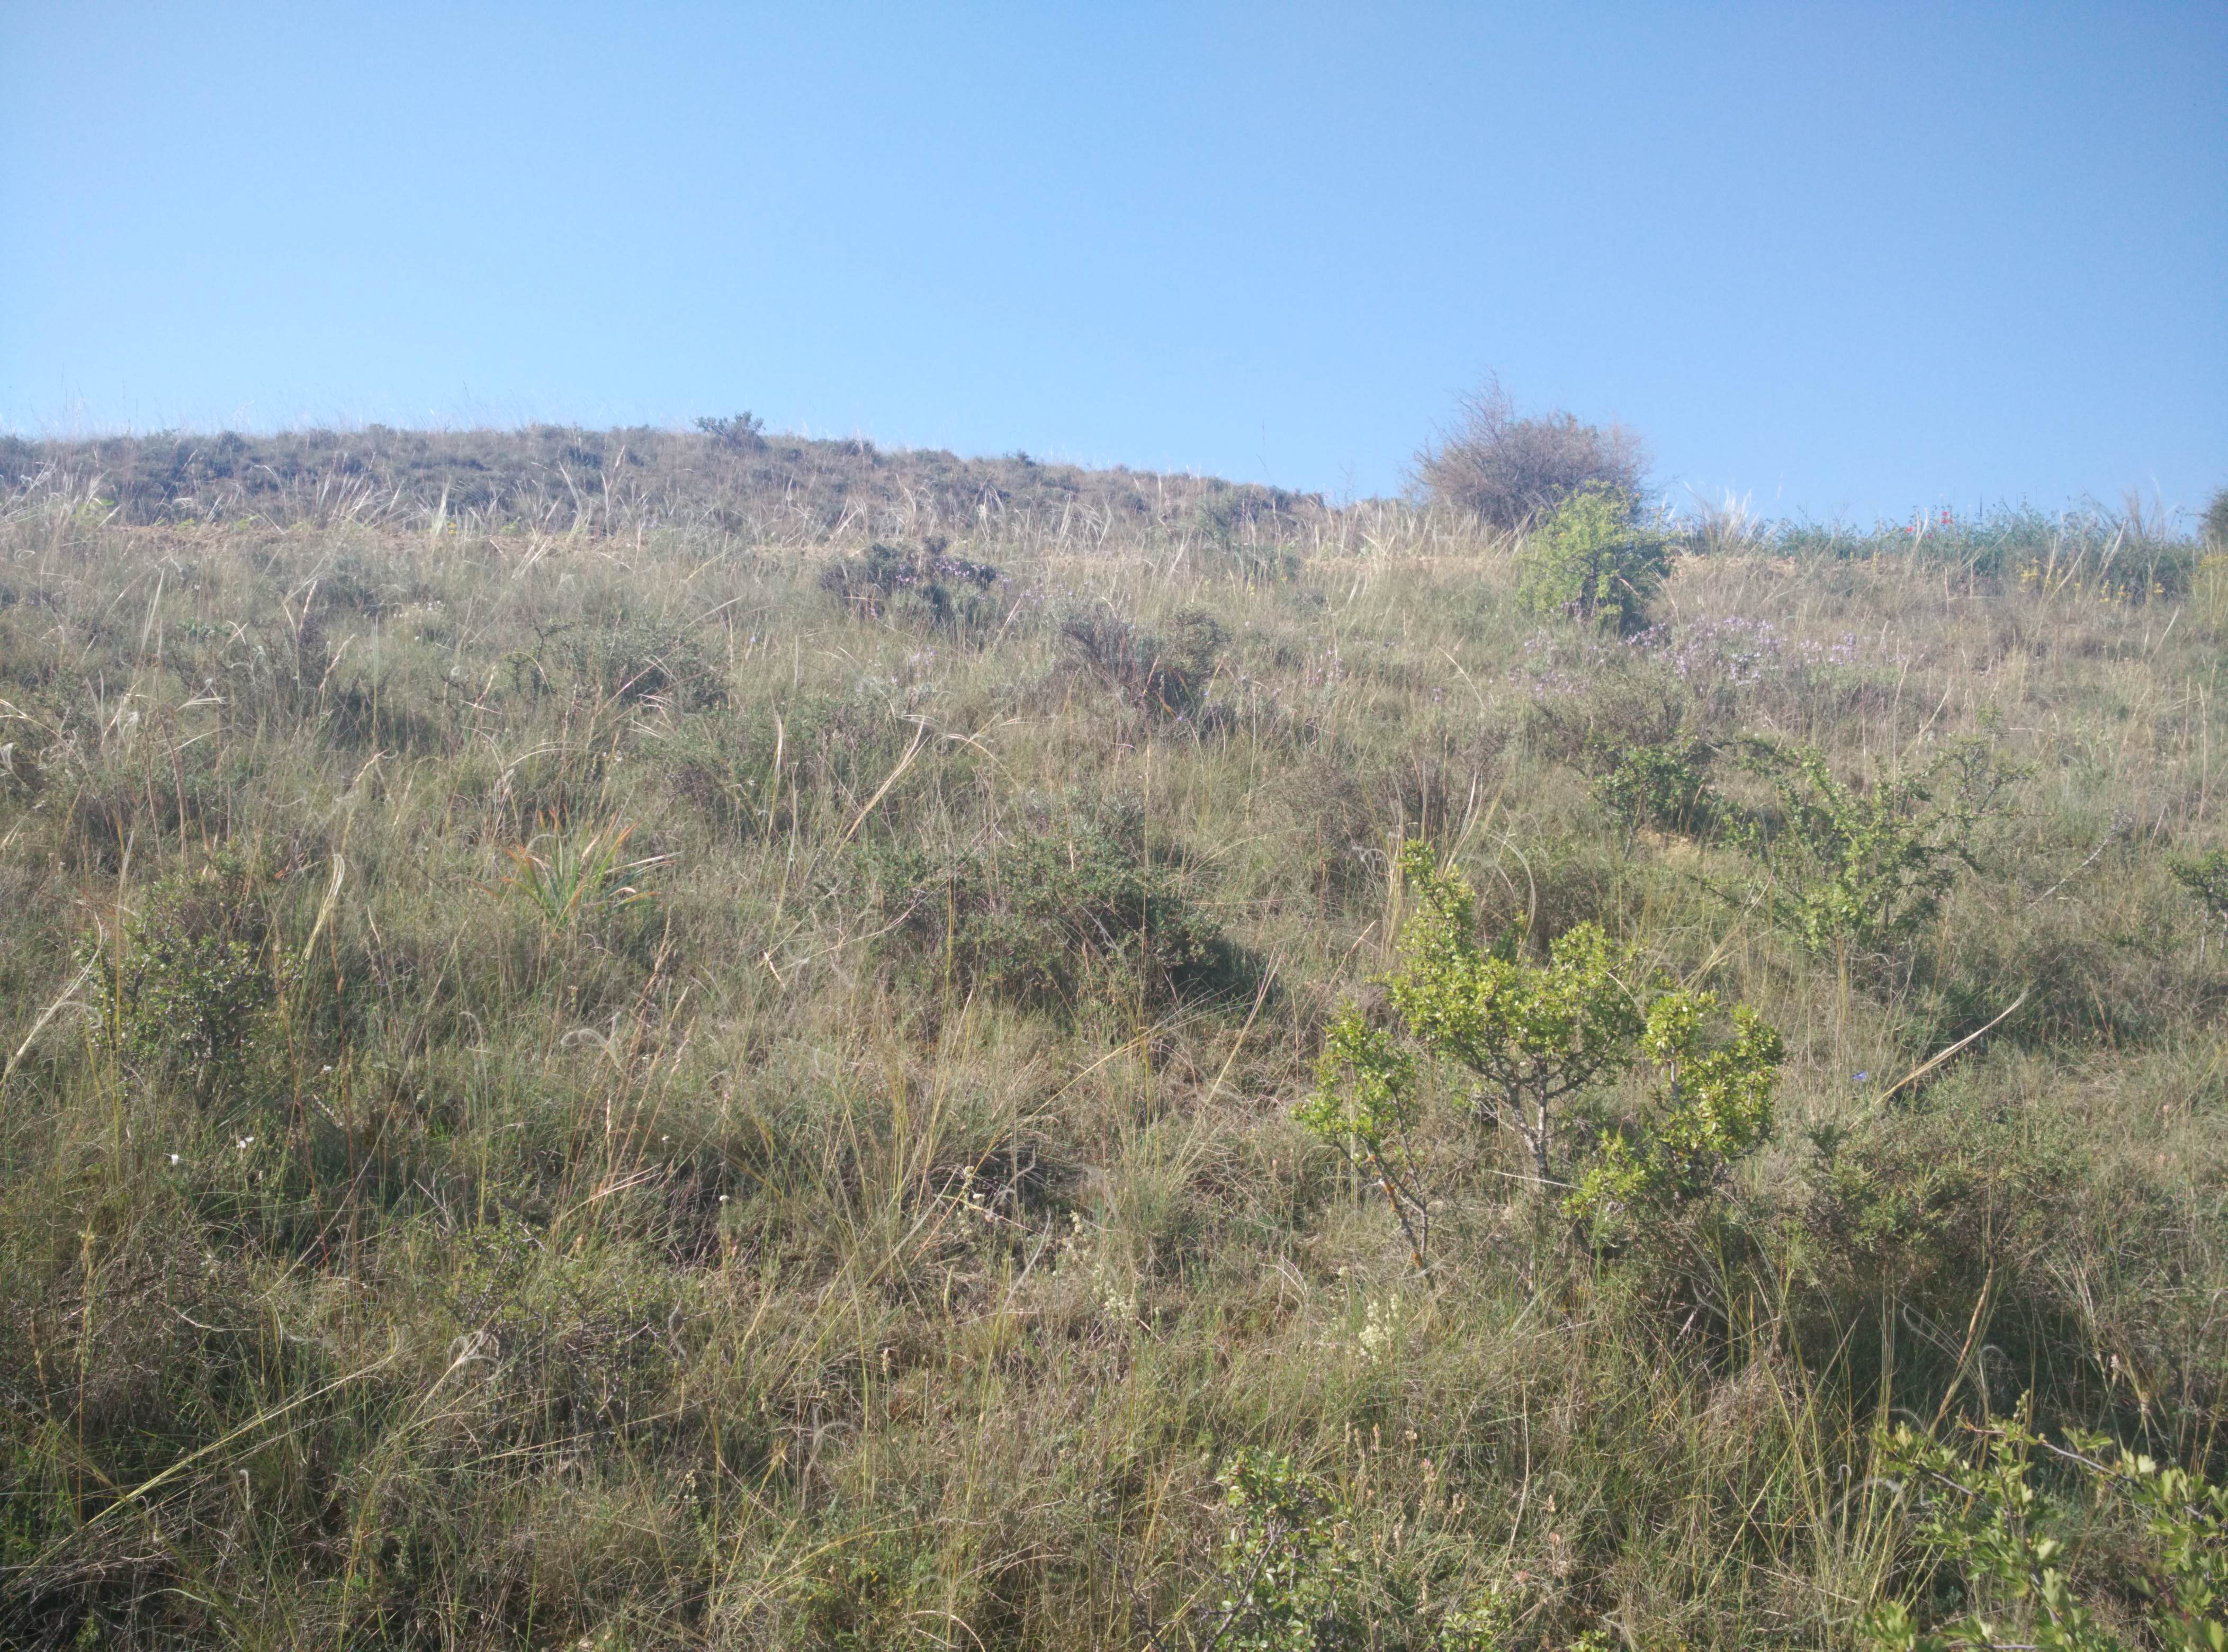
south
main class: Shrubland
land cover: Shrubland without tree cover
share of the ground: 10 - 25 %
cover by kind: herbaceous plants 60 %, shrubs 20 %, unconsolidated bare surface 20 %
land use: Semi-natural and natural areas not in use
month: June
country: ES
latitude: 40.7926
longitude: -1.8132
